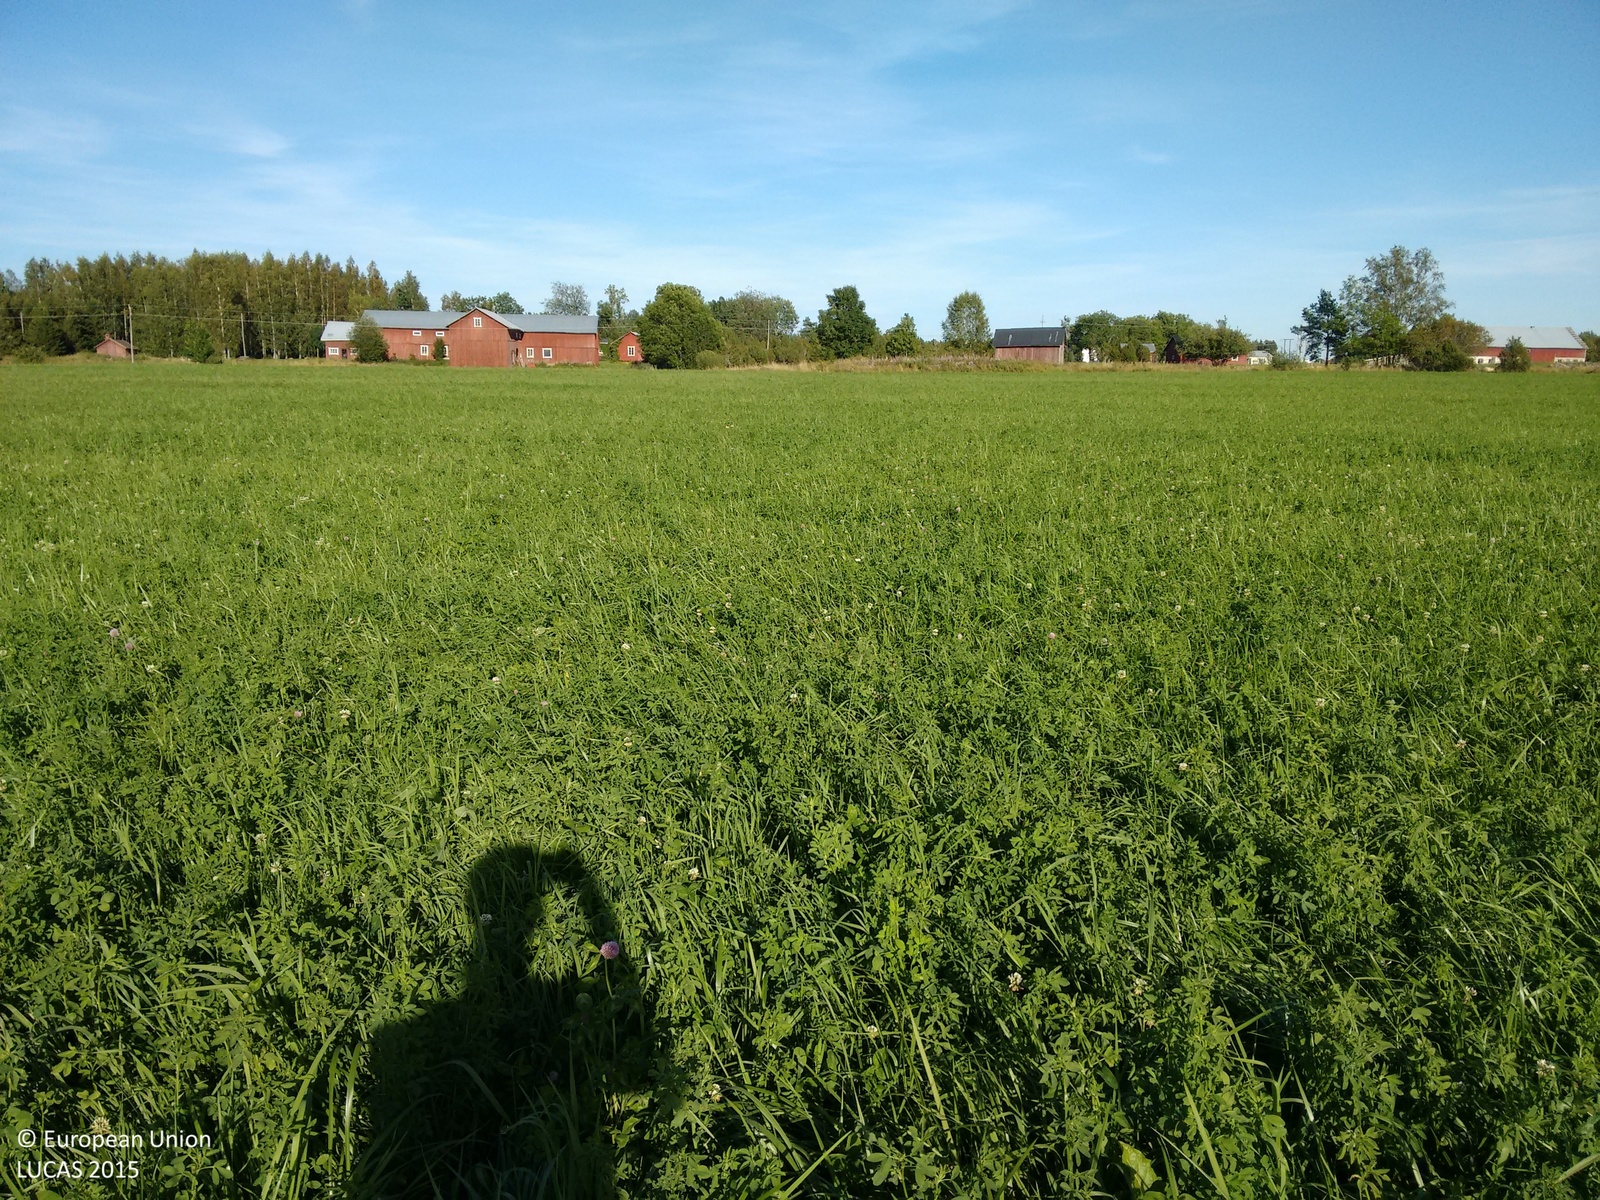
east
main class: Cropland
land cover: Temporary grasslands
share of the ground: > 75 %
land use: Agriculture (excluding fallow land and kitchen gardens)
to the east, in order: Temporary grasslands; Spontaneously vegetated surfaces; Tracks; Grass margins; Fences; Grassland without tree/shrub cover; Ditches and canals; Fences; Other coniferous woodland
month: August
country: FI
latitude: 60.1944
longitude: 19.9079
